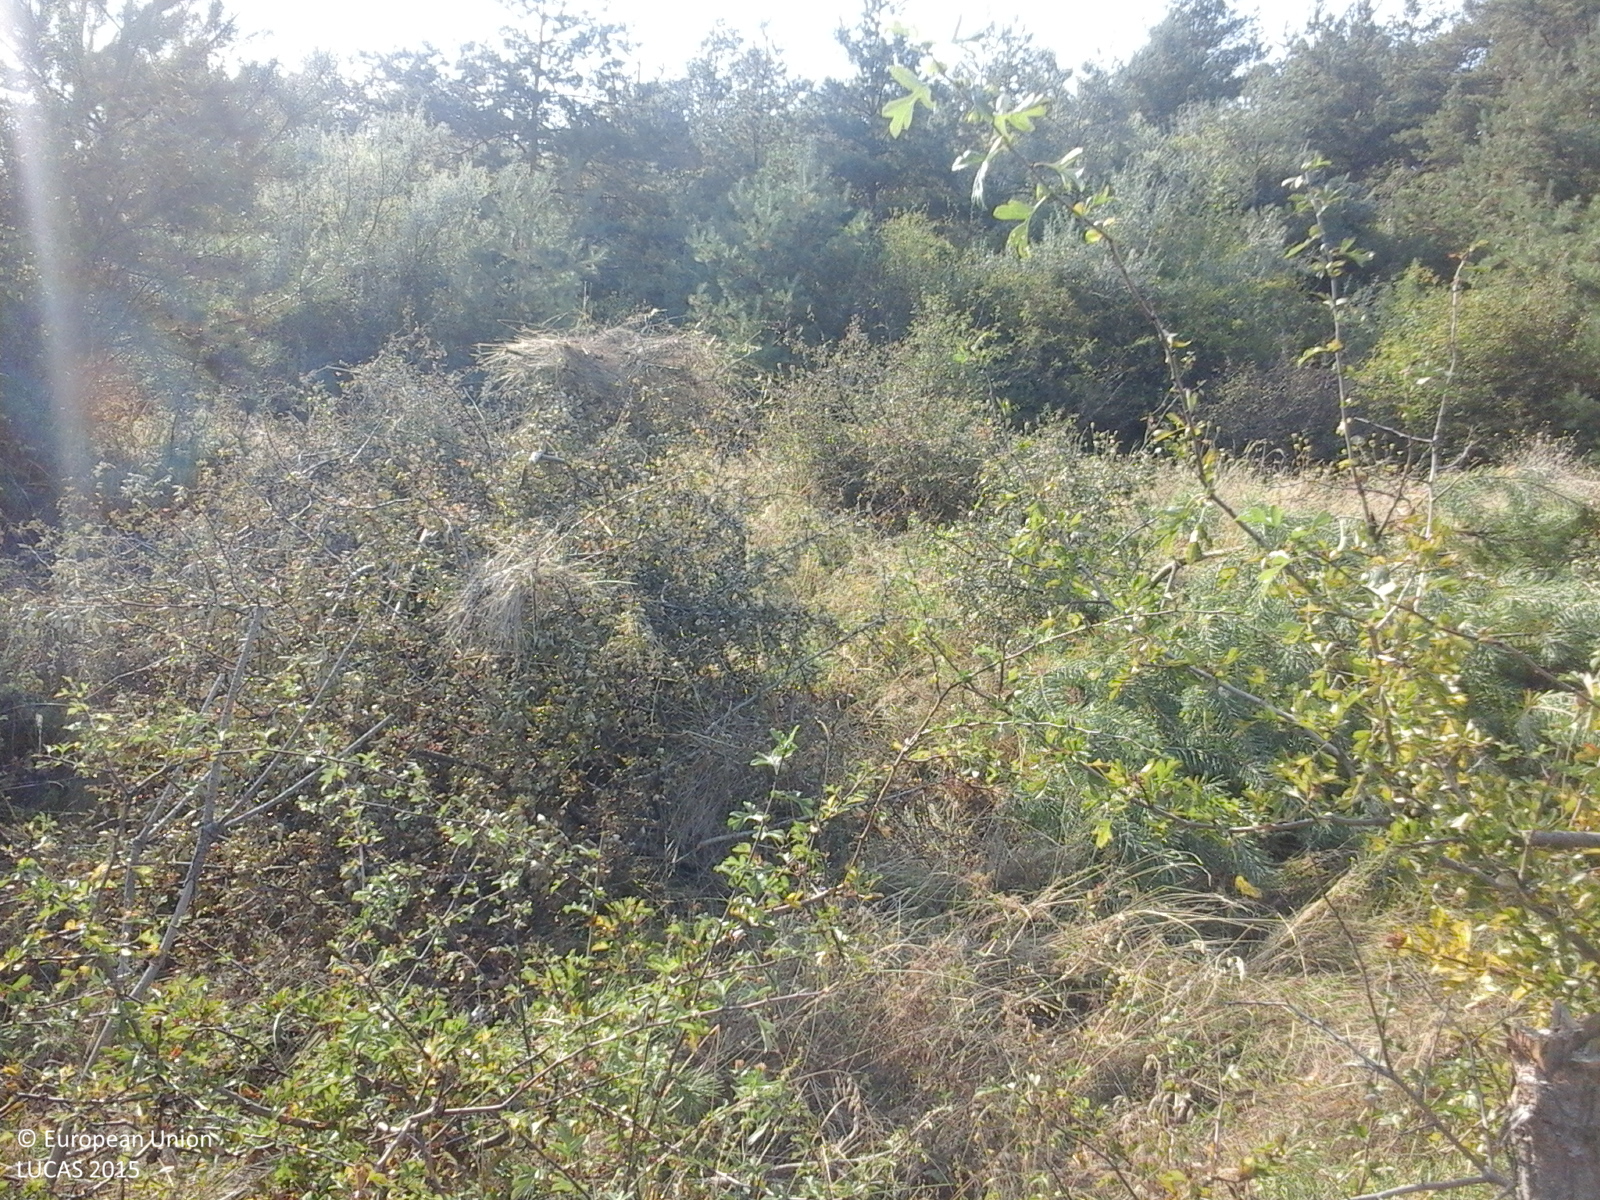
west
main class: Grassland
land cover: Grassland with sparse tree/shrub cover
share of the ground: > 75 %
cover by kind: herbaceous plants 85 %, shrubs 10 %, broadleaved forest trees 5 %
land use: Forestry
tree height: < 5 m
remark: Clear cut
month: September
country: RO
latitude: 47.1226
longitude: 24.1482
